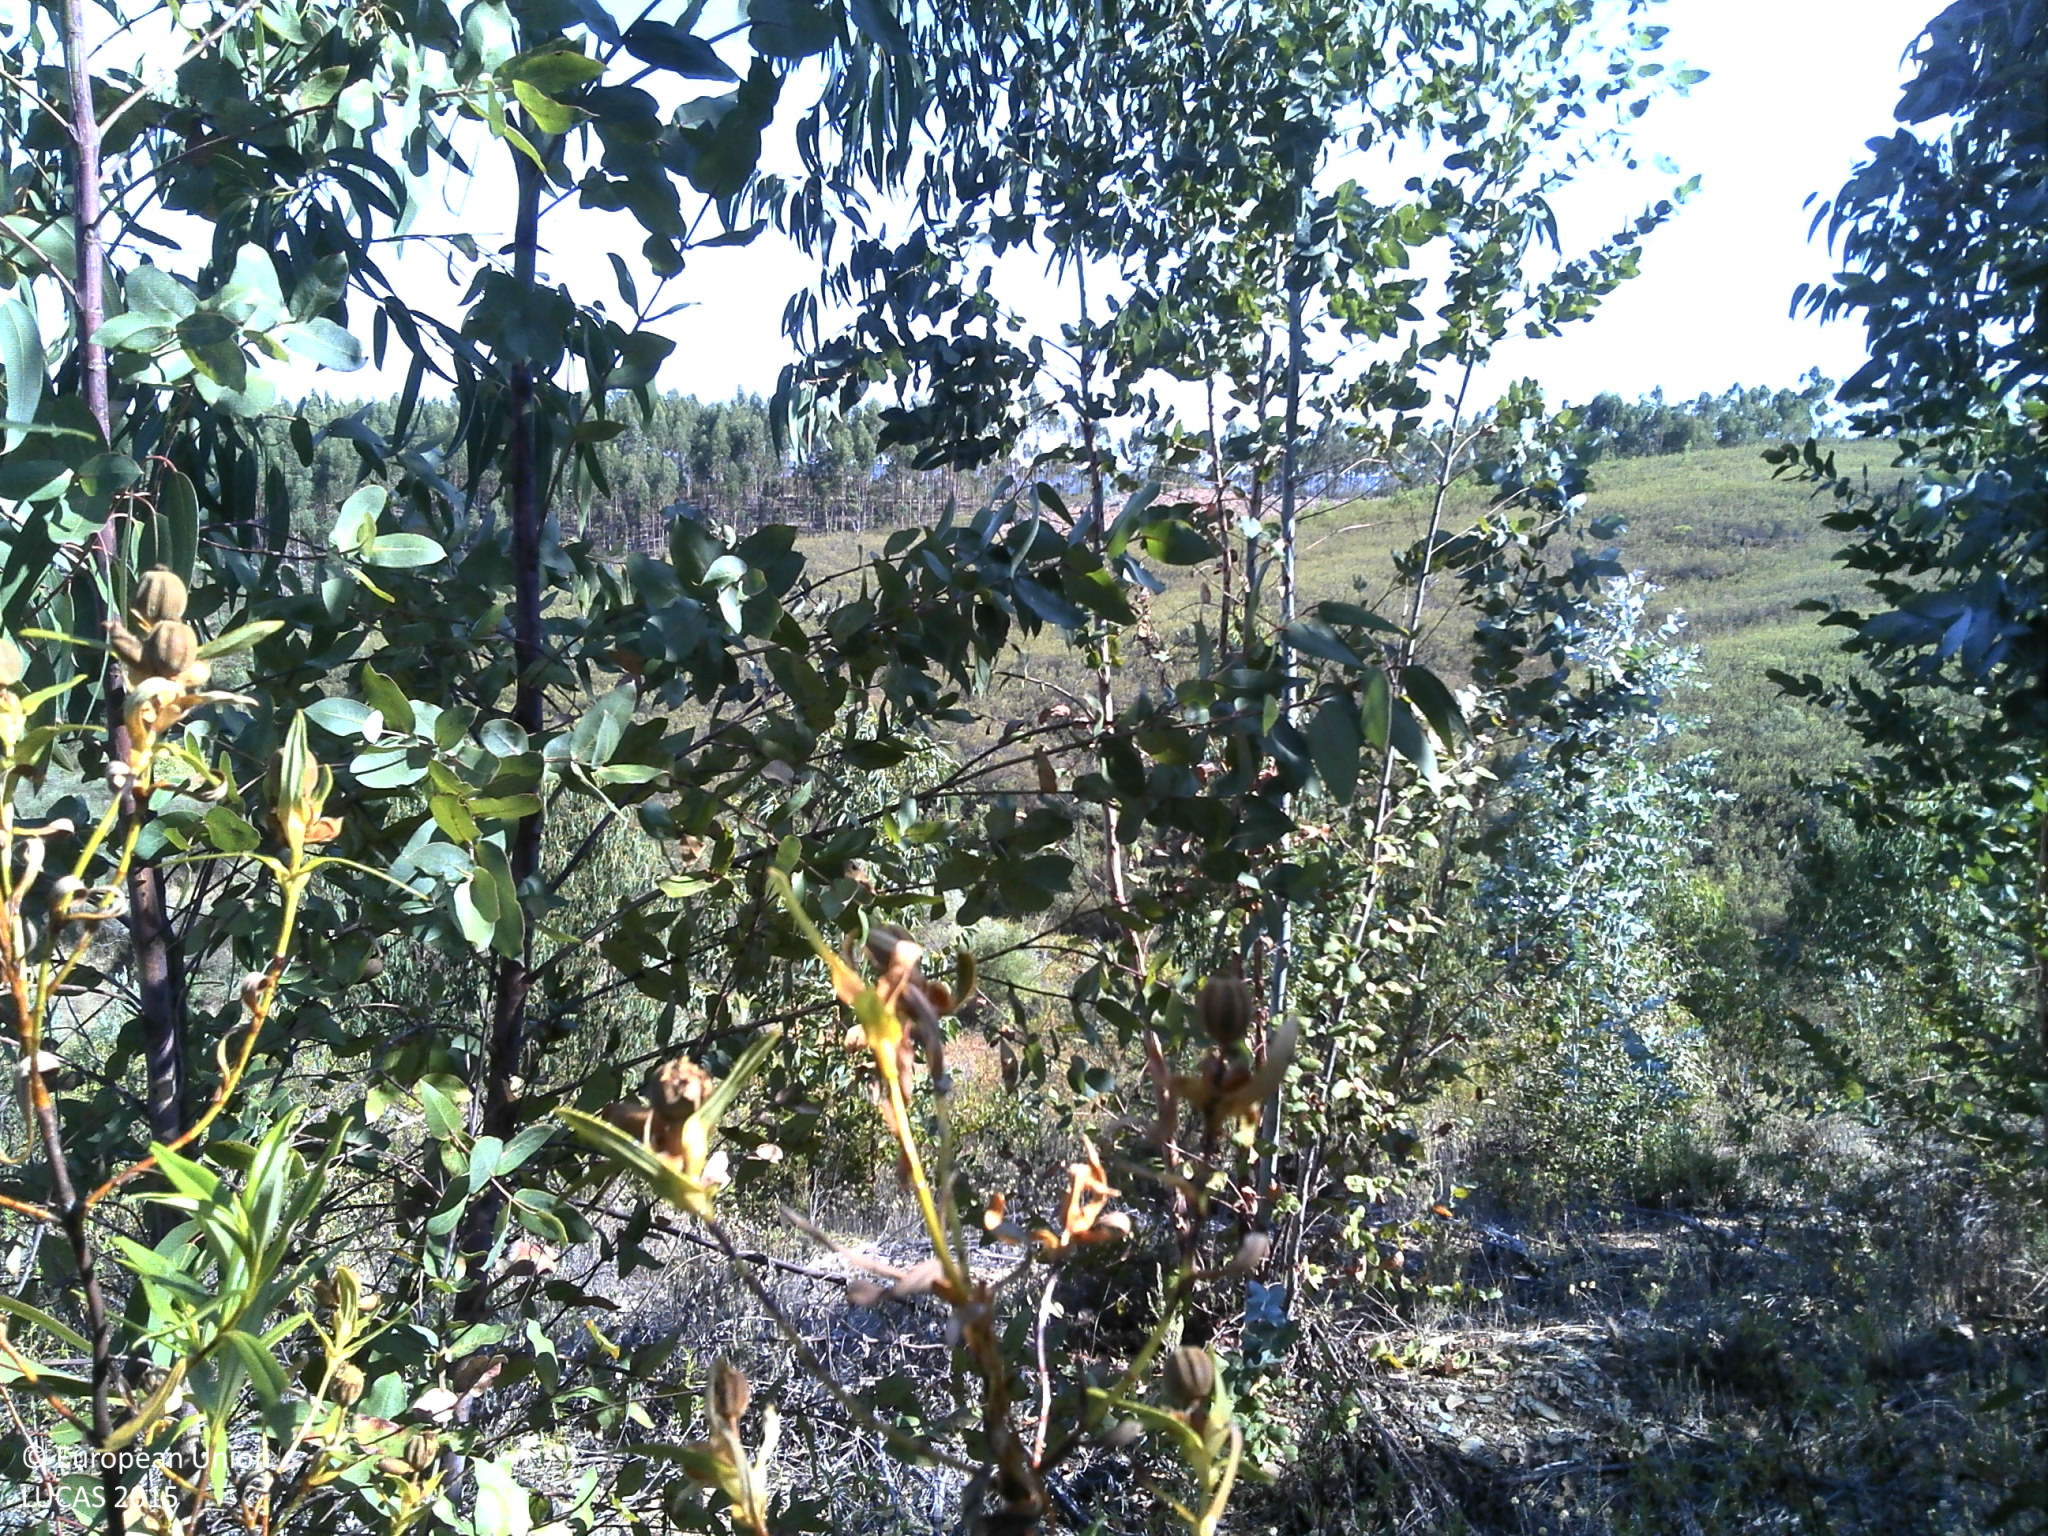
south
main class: Woodland
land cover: Broadleaved woodland
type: exotic forest
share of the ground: 10 - 25 %
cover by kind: shrubs 70 %, broadleaved forest trees 15 %, unconsolidated bare surface 15 %
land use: Forestry
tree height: > 5 m
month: July
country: PT
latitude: 39.6135
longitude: -7.7480
